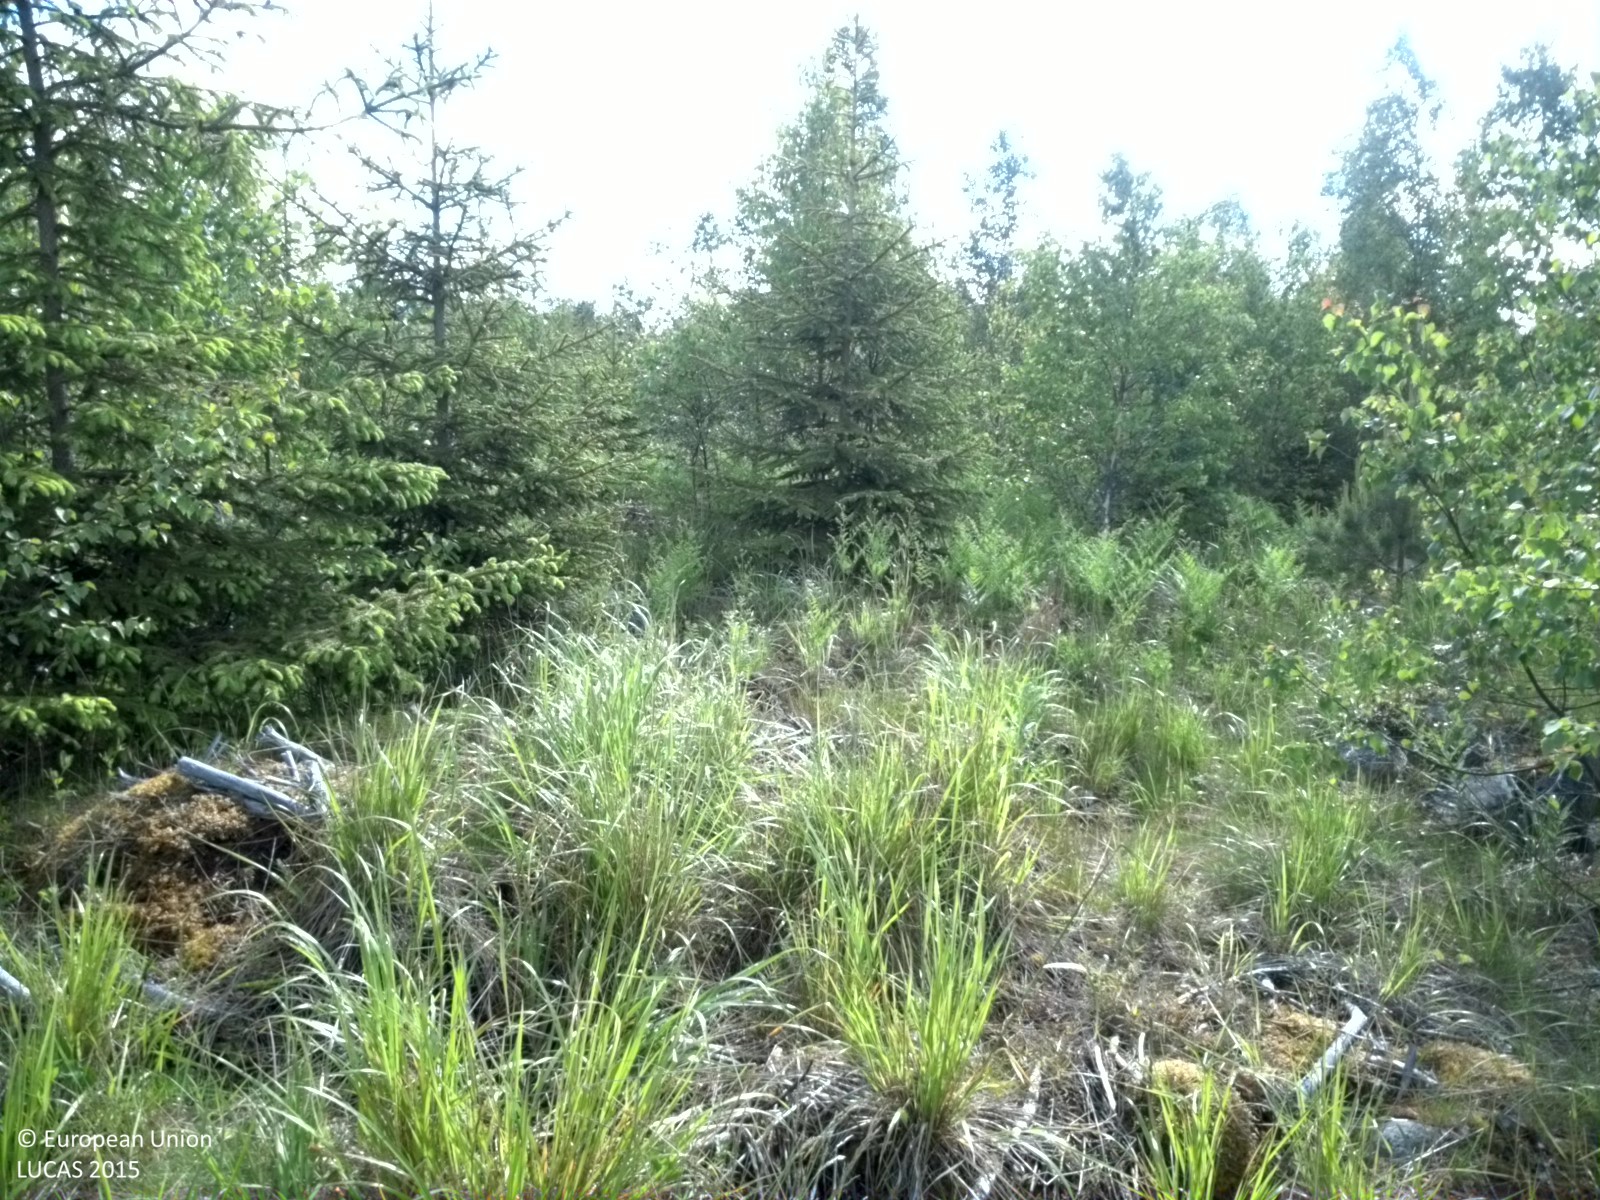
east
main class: Woodland
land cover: Spruce dominated mixed woodland
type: boreal forest
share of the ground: 50 - 75 %
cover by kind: broadleaved forest trees 30 %, coniferous forest trees 25 %, herbaceous plants 20 %, lichens and mosses 10 %, consolidated bare surface 10 %, shrubs 5 %
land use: Forestry
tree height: < 5 m
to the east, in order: Spruce dominated mixed woodland; Broadleaved woodland; Ditches and canals; Spruce dominated mixed woodland; Other mixed woodland; Spruce dominated coniferous woodland; Ditches and canals; Spruce dominated coniferous woodland
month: June
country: SE
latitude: 60.1500
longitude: 17.7204
